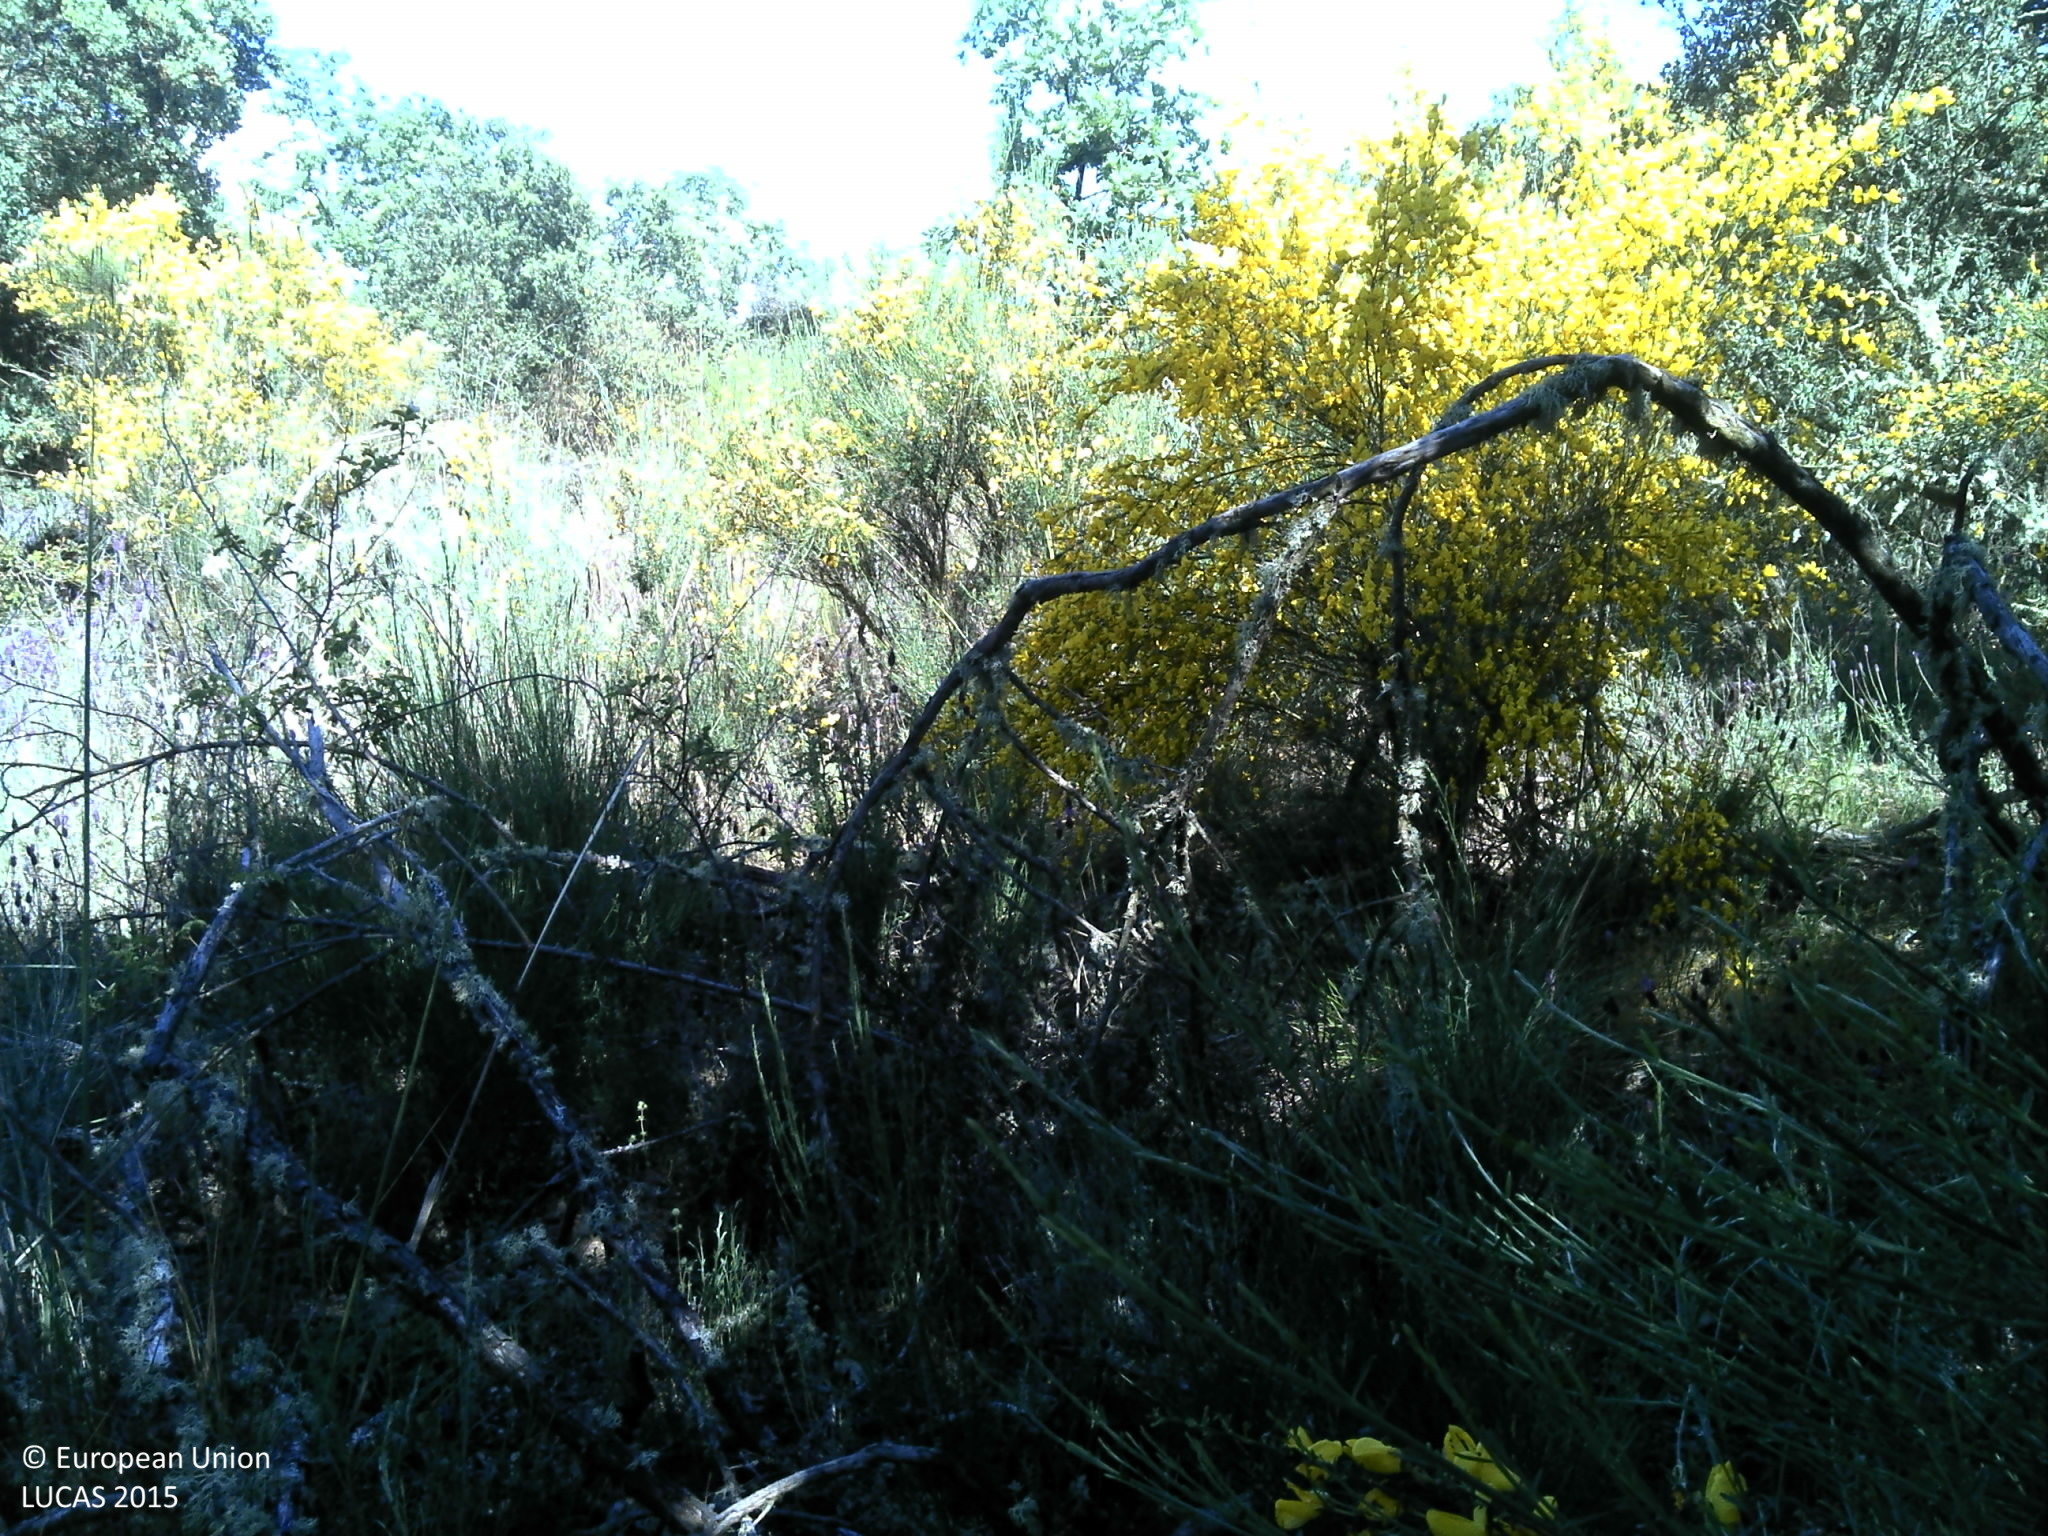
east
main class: Woodland
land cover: Broadleaved woodland
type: broadleaved evergreen forest
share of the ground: 25 - 50 %
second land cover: Shrubland without tree cover
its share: 25 - 50 %
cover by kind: shrubs 50 %, broadleaved forest trees 25 %, unconsolidated bare surface 15 %, herbaceous plants 10 %
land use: Forestry
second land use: Agriculture (excluding fallow land and kitchen gardens)
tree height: > 5 m
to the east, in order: Broadleaved woodland; Shrubland without tree cover; Broadleaved woodland; Lines of trees; Dry stone walls; Grassland with sparse tree/shrub cover; Shrubland with sparse tree cover; Grassland with sparse tree/shrub cover; Dry stone walls; Lines of trees; Grassland with sparse tree/shrub cover
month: May
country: PT
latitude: 41.6153
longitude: -6.3132
